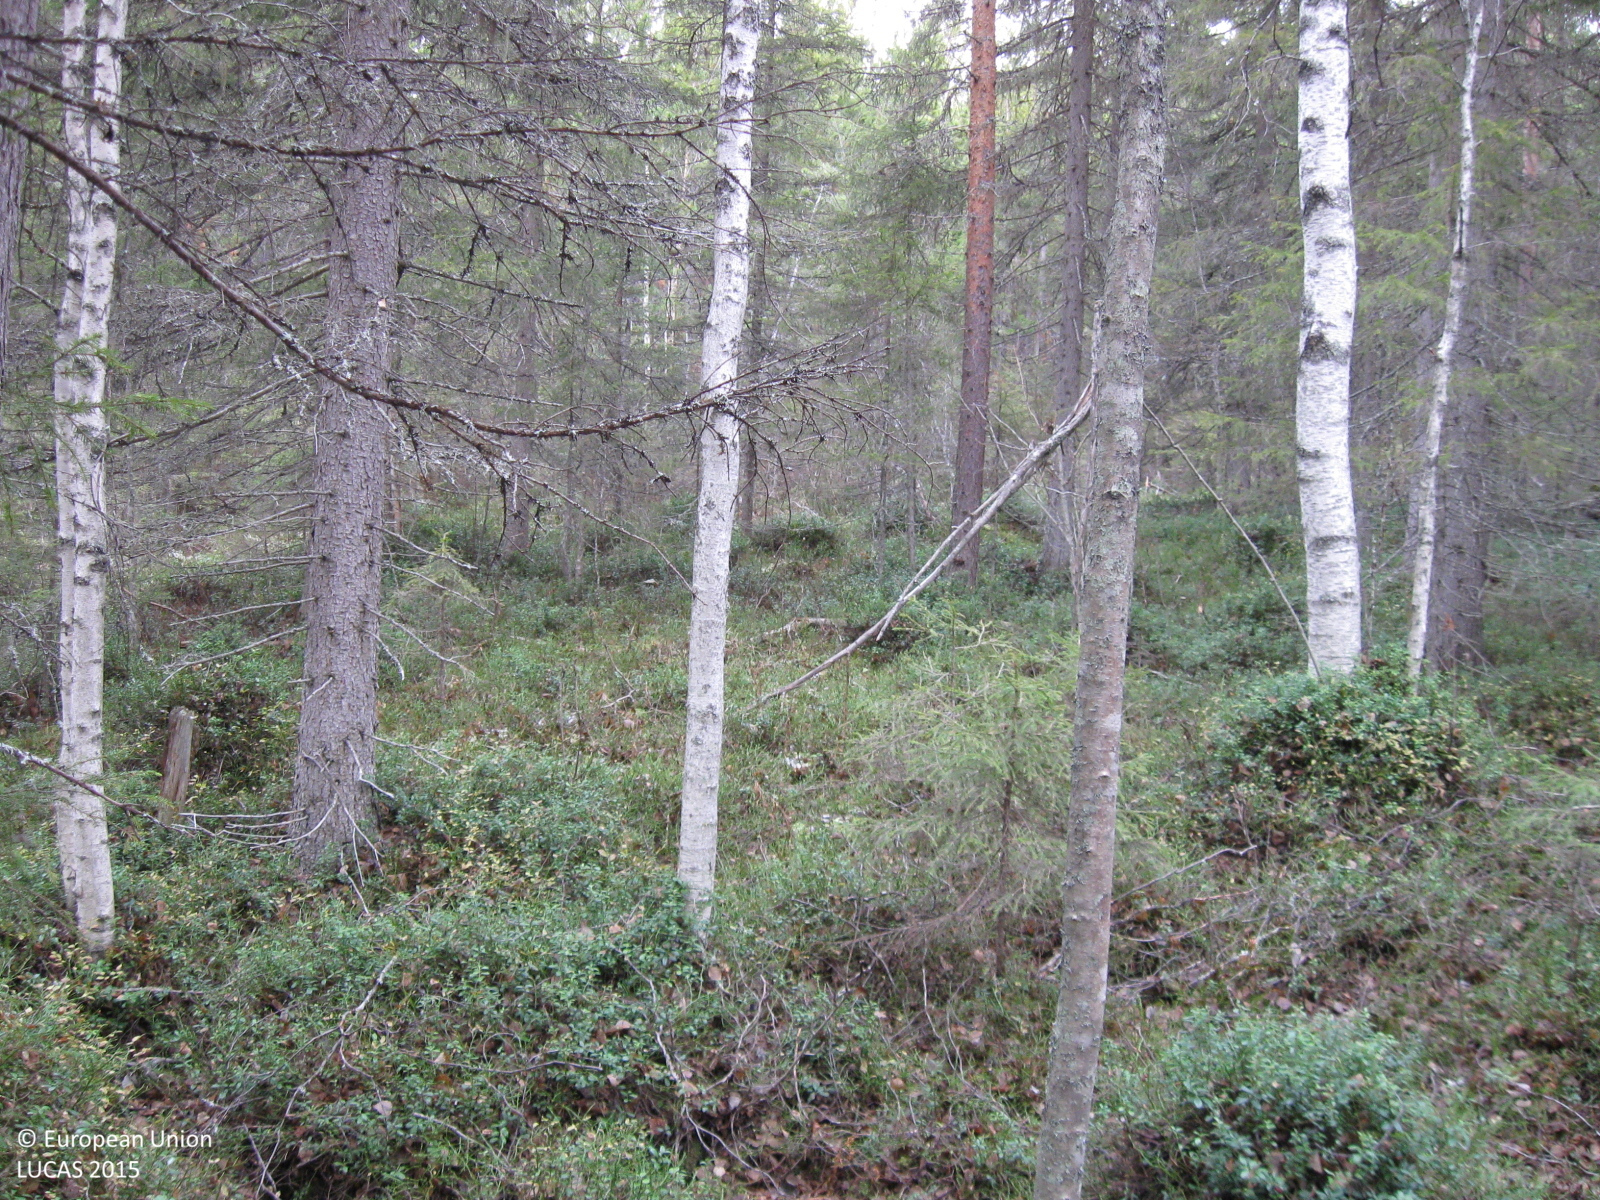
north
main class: Woodland
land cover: Other mixed woodland
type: boreal forest
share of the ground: > 75 %
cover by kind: coniferous forest trees 60 %, broadleaved forest trees 20 %, shrubs 10 %, herbaceous plants 5 %, lichens and mosses 5 %
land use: Forestry
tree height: > 5 m
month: October
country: SE
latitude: 66.1740
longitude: 21.5248
